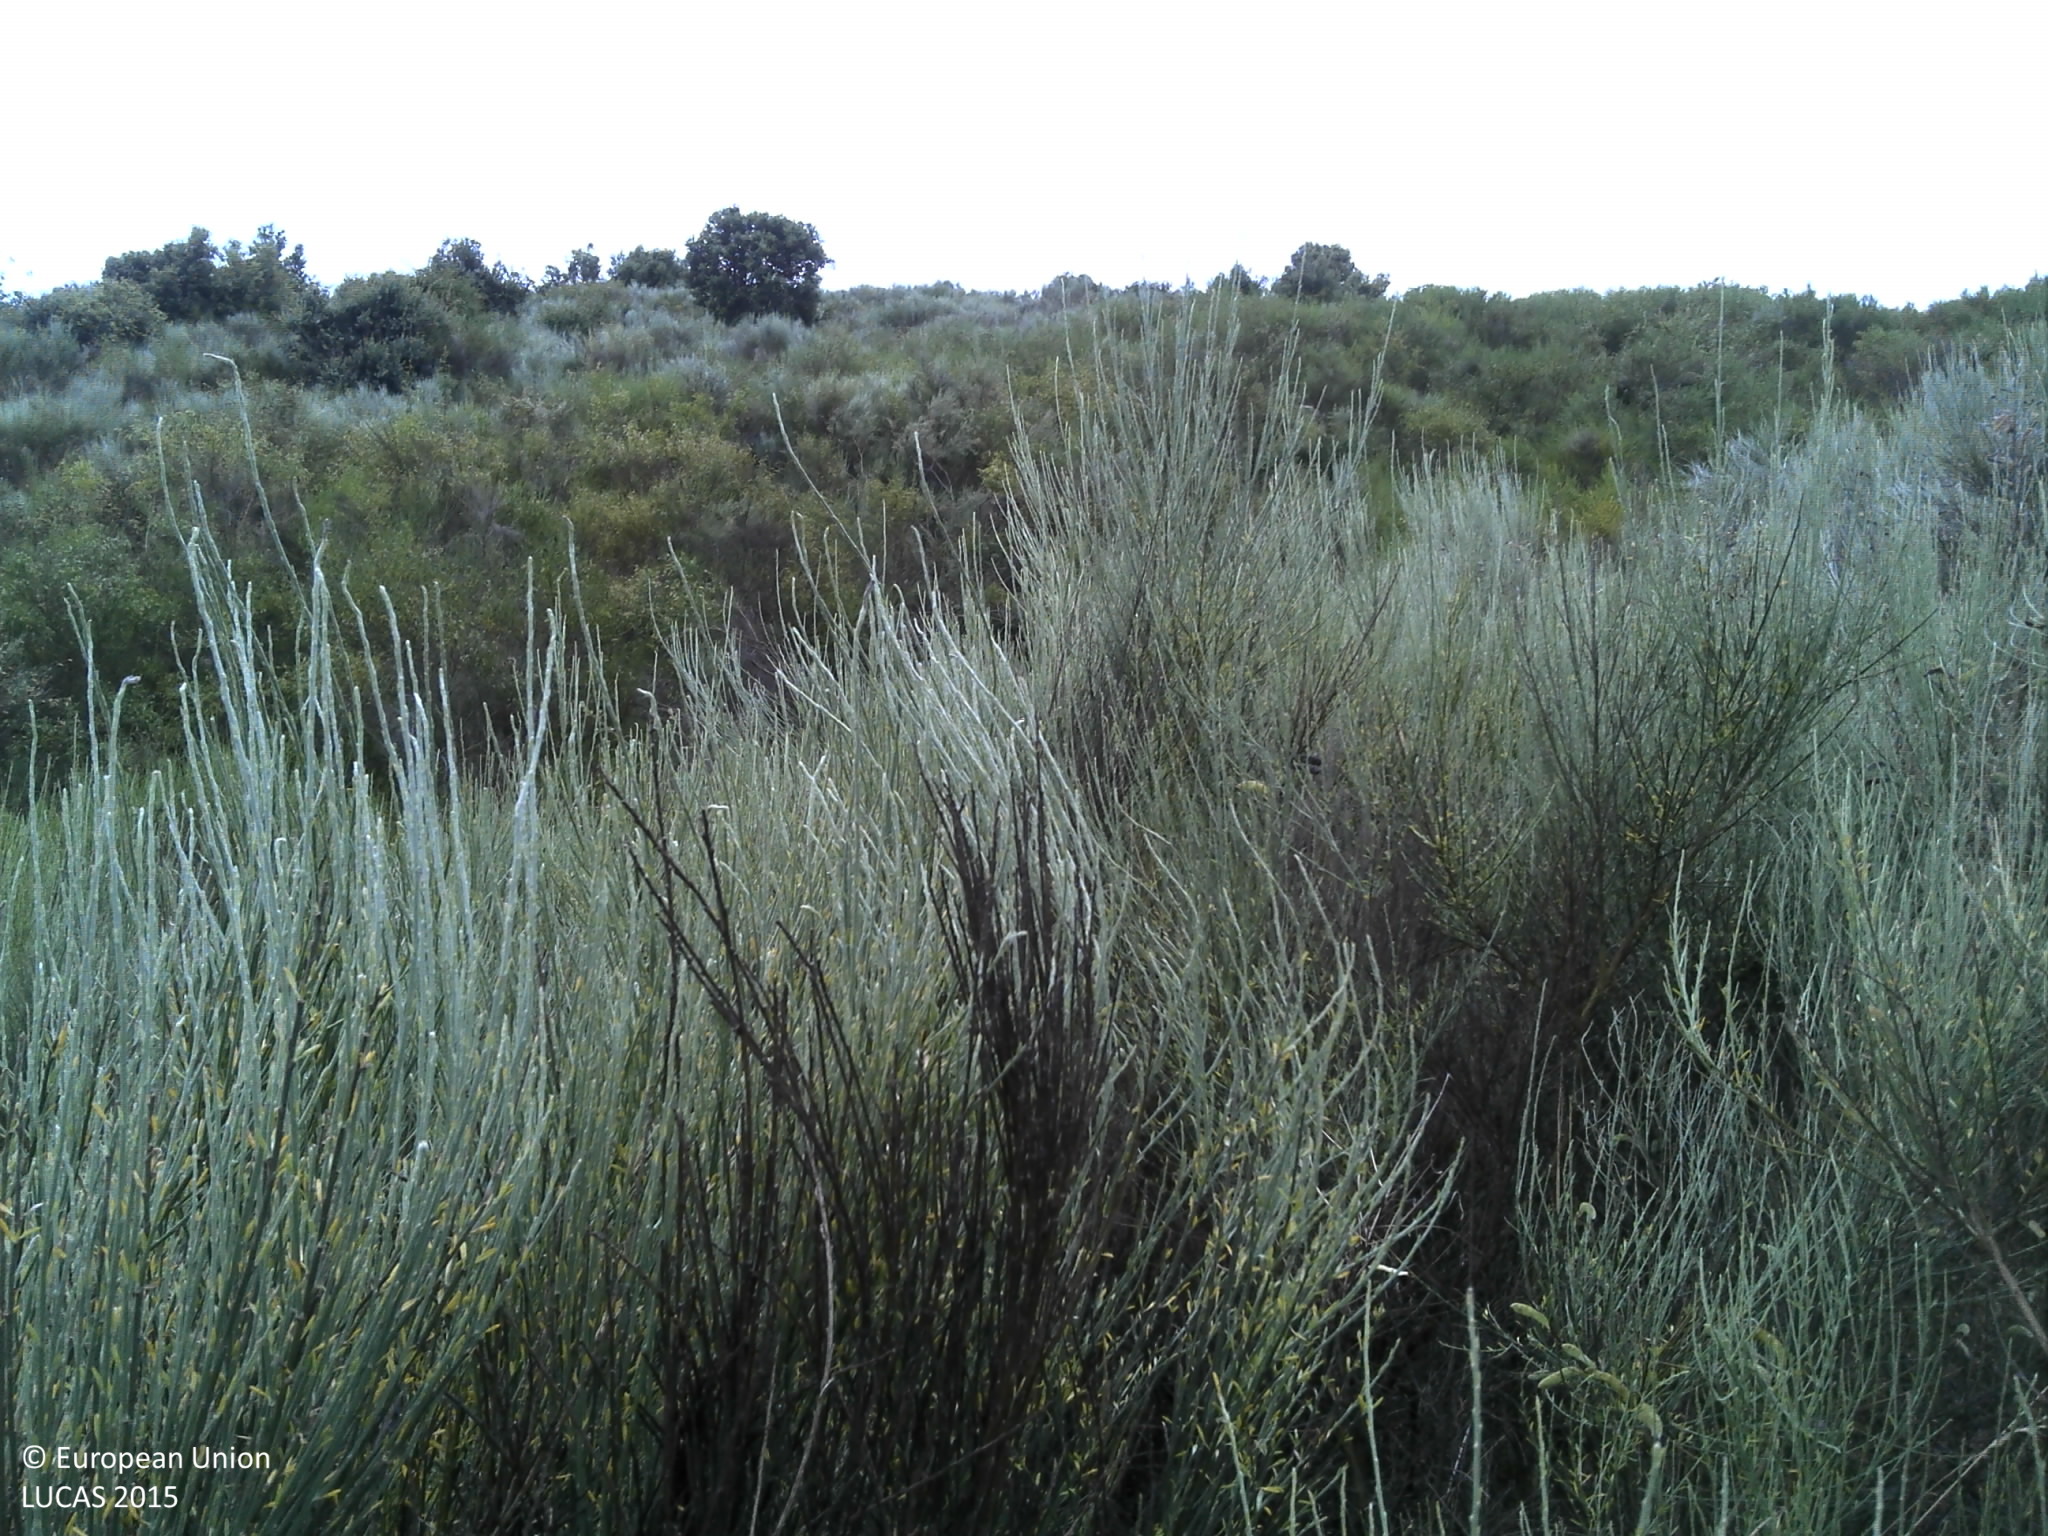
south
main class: Shrubland
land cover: Shrubland without tree cover
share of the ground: > 75 %
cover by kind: shrubs 100 %
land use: Semi-natural and natural areas not in use
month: June
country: PT
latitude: 41.3206
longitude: -6.9676
